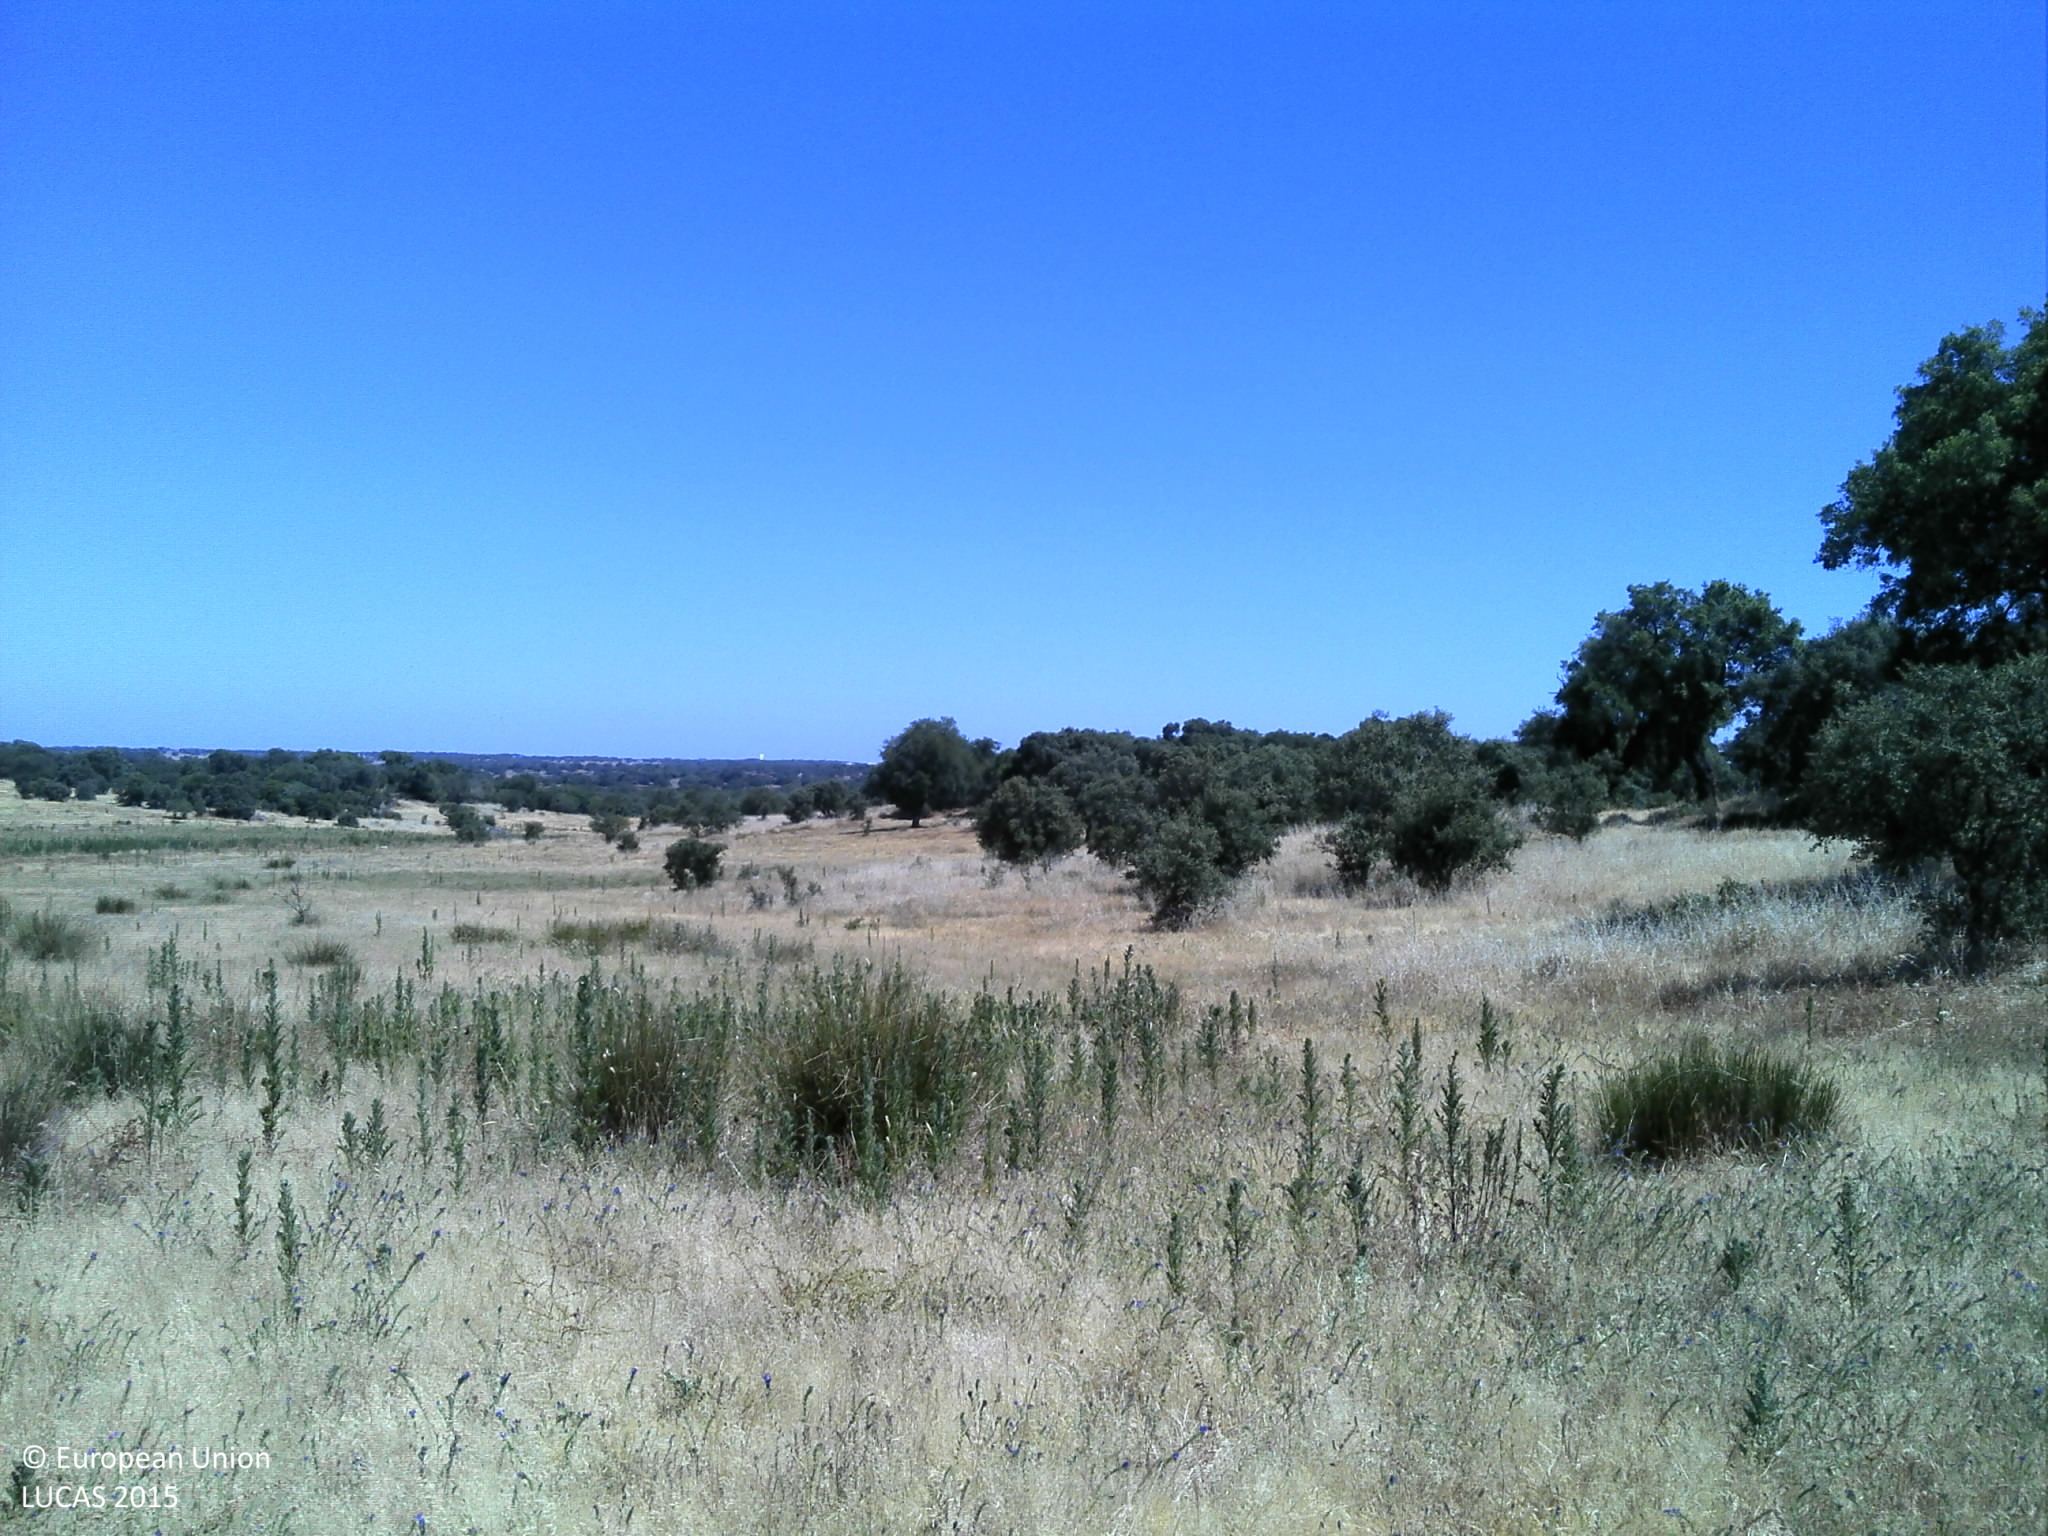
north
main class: Grassland
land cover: Grassland with sparse tree/shrub cover
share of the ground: 25 - 50 %
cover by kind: herbaceous plants 90 %, broadleaved forest trees 5 %, unconsolidated bare surface 5 %
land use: Agriculture (excluding fallow land and kitchen gardens)
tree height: < 5 m
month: June
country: PT
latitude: 38.7353
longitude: -8.1914
